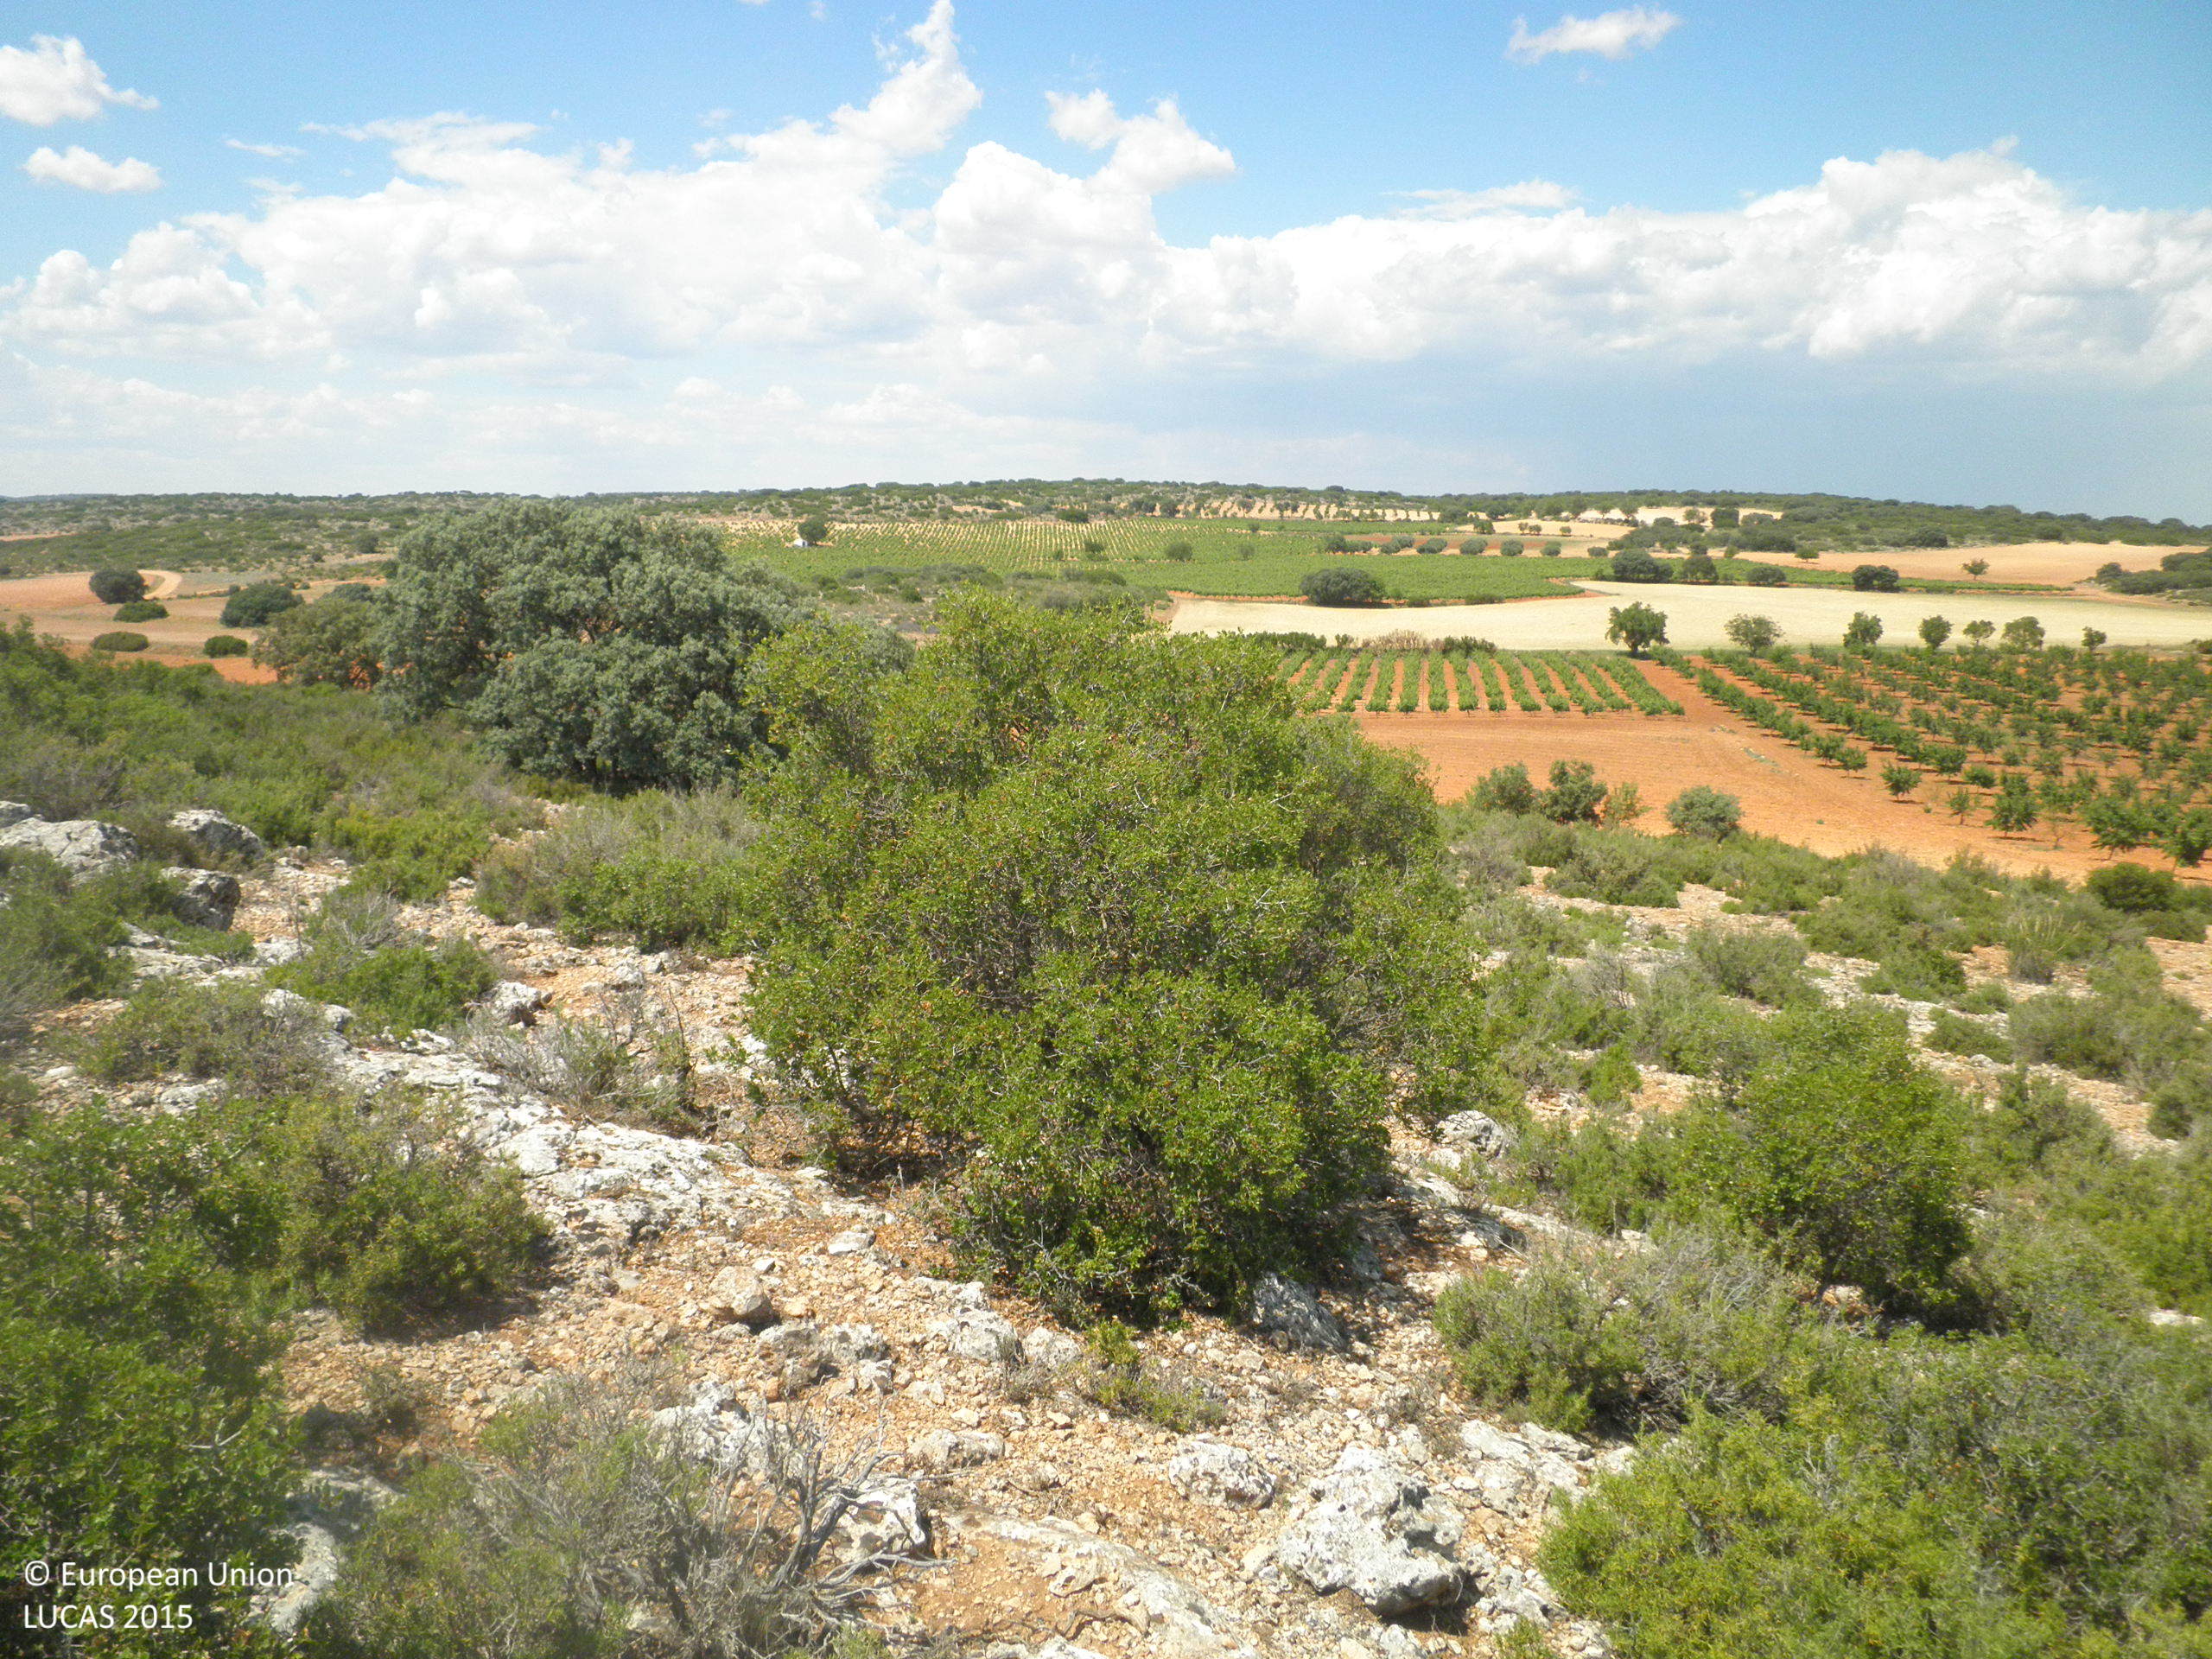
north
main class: Shrubland
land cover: Shrubland without tree cover
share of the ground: 25 - 50 %
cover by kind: consolidated bare surface 50 %, shrubs 40 %, unconsolidated bare surface 10 %
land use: Semi-natural and natural areas not in use
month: June
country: ES
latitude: 39.4844
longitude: -1.7599
